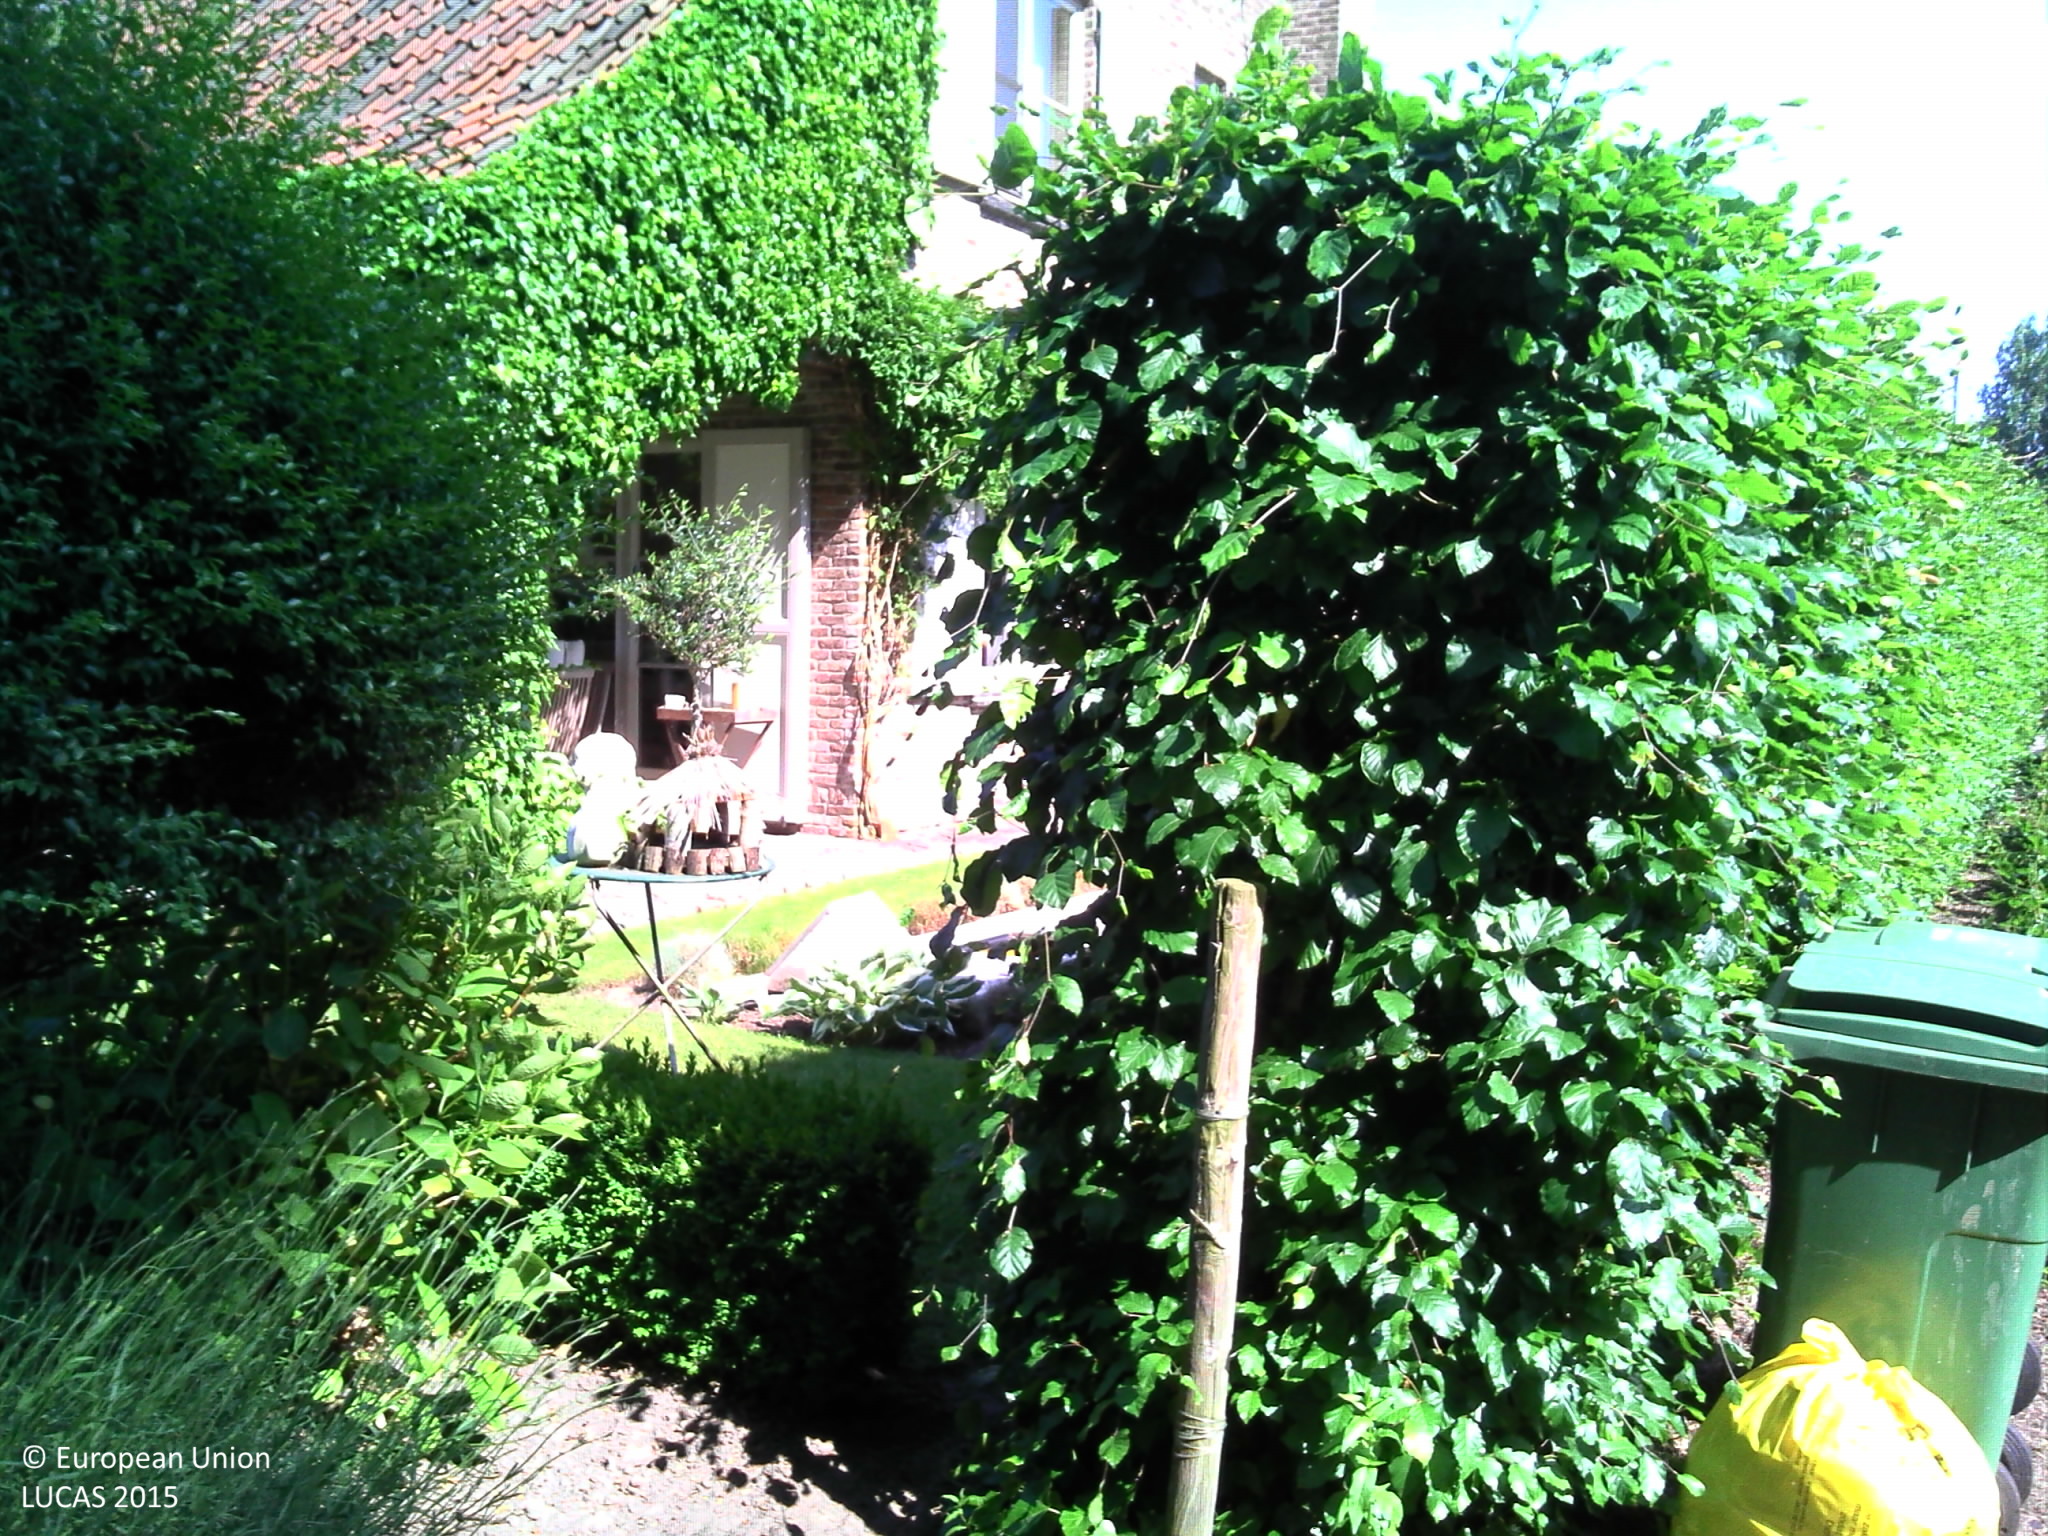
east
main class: Grassland
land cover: Grassland without tree/shrub cover
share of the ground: > 75 %
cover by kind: herbaceous plants 100 %
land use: Residential
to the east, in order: Grassland without tree/shrub cover; Artificial constructions in urban areas
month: June
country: BE
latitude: 51.0116
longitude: 3.8790
